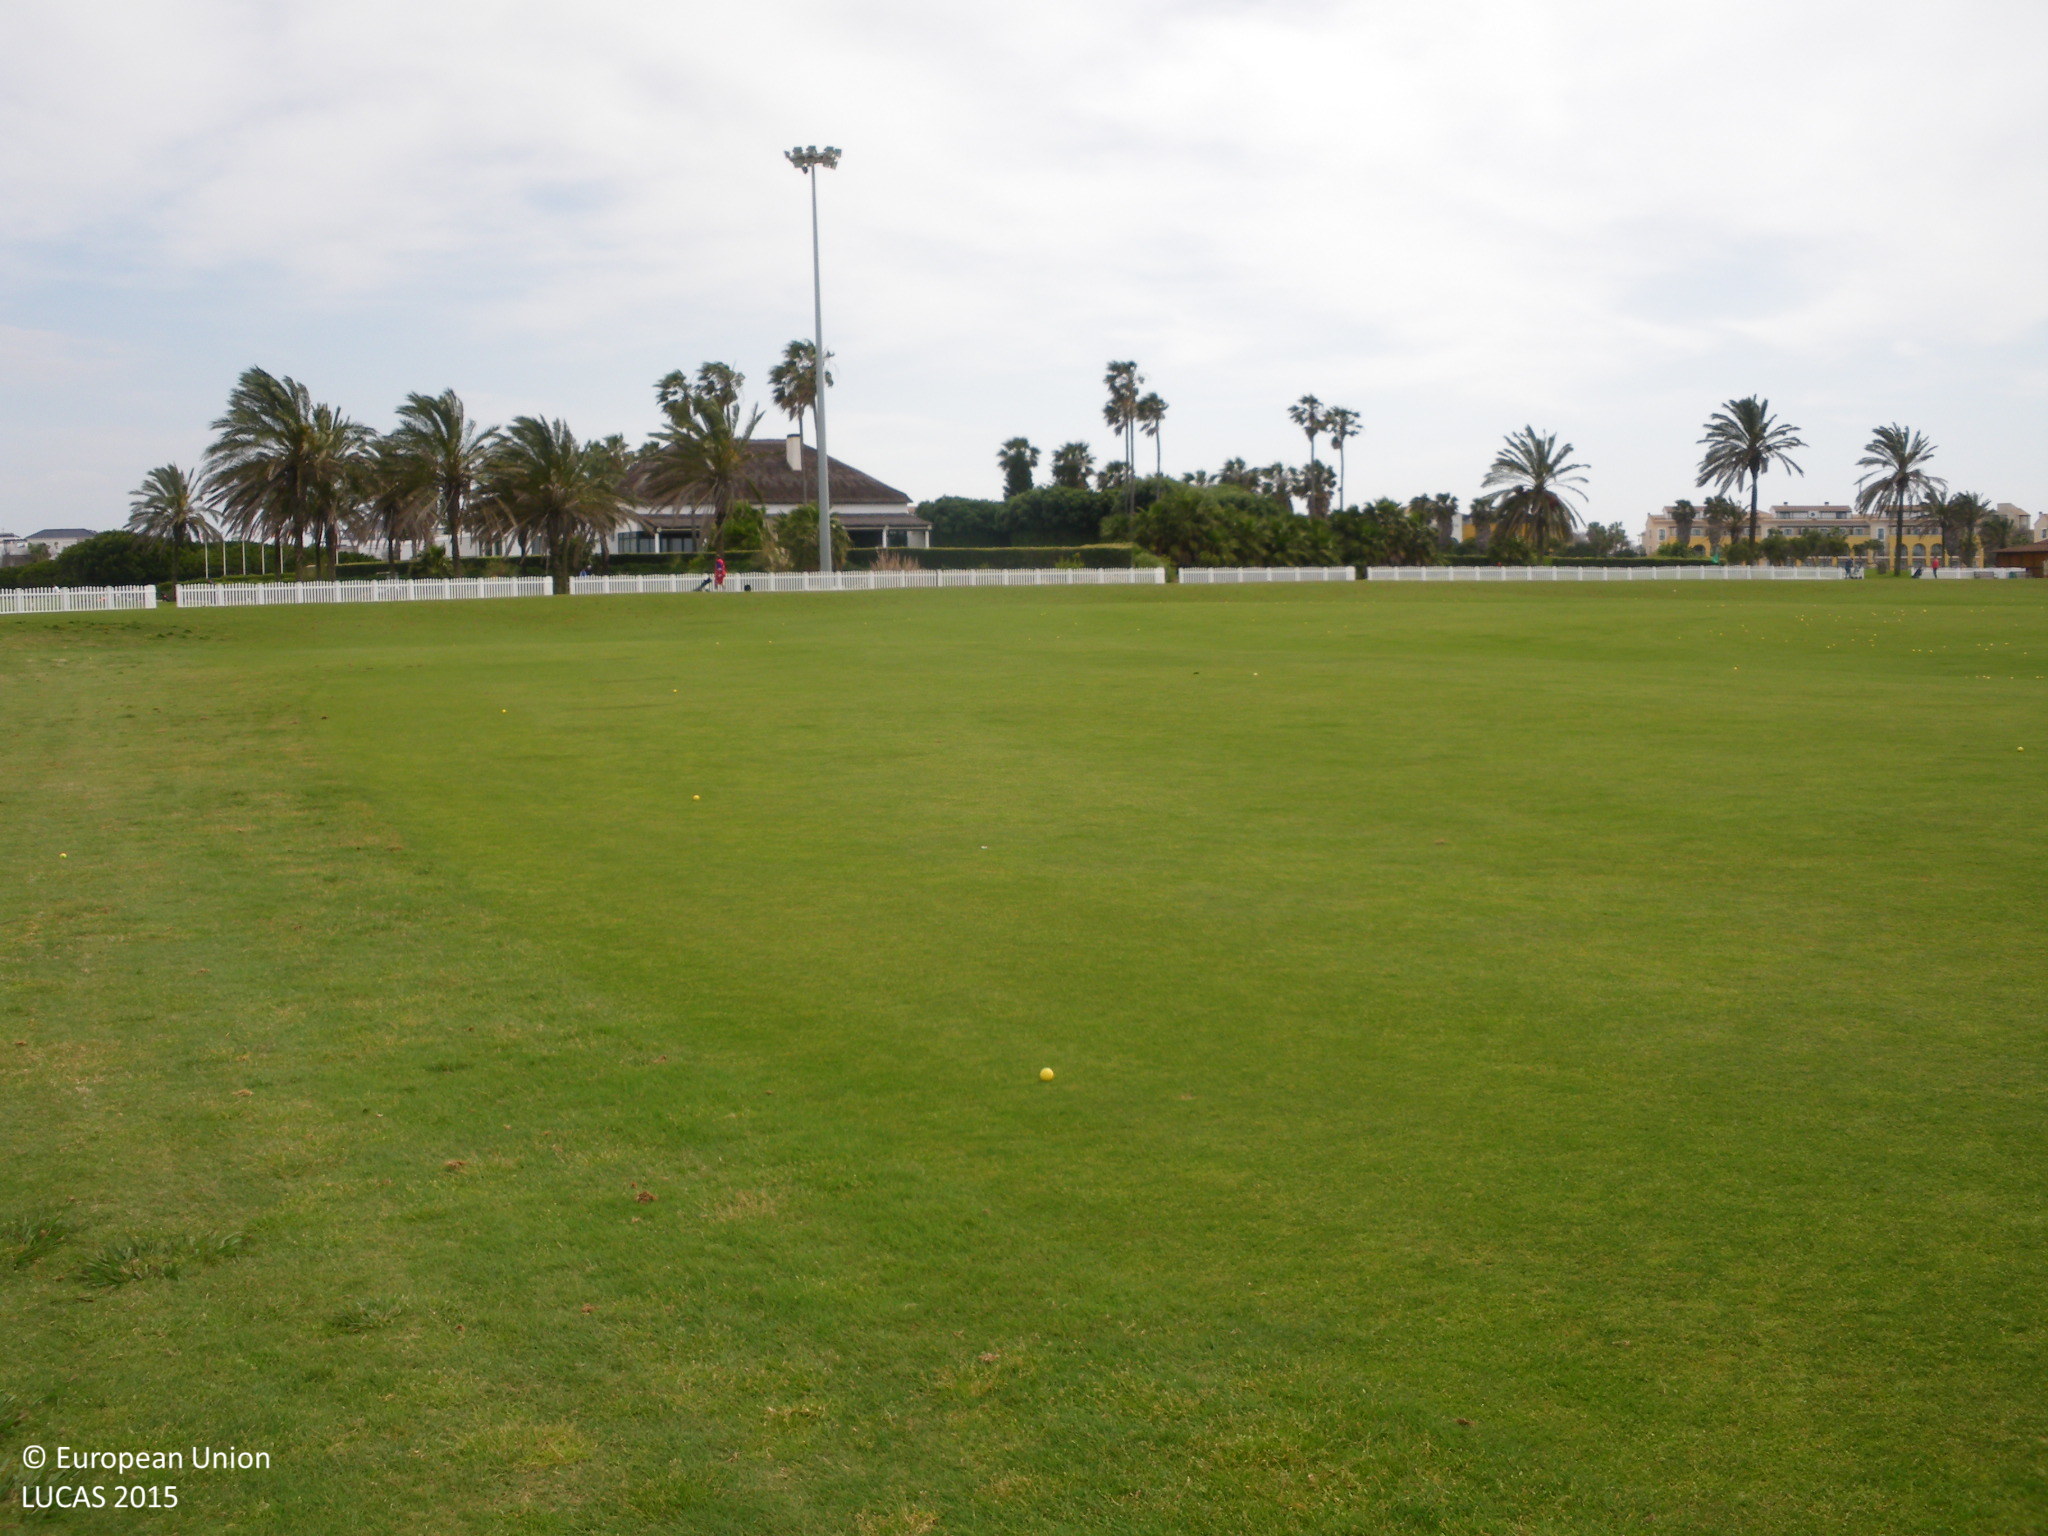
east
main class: Grassland
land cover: Grassland without tree/shrub cover
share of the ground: > 75 %
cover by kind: herbaceous plants 100 %
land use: Sport
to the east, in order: Grassland without tree/shrub cover; Fences; Grassland without tree/shrub cover; Tracks; Shrubland with sparse tree cover; Managed hedges; Grassland without tree/shrub cover; Managed hedges; Broadleaved woodland; Lines of trees; Artificial constructions in urban areas; Managed hedges; Grassland without tree/shrub cover; Inland fresh water bodies
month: April
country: ES
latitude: 36.6805
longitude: -6.4105
